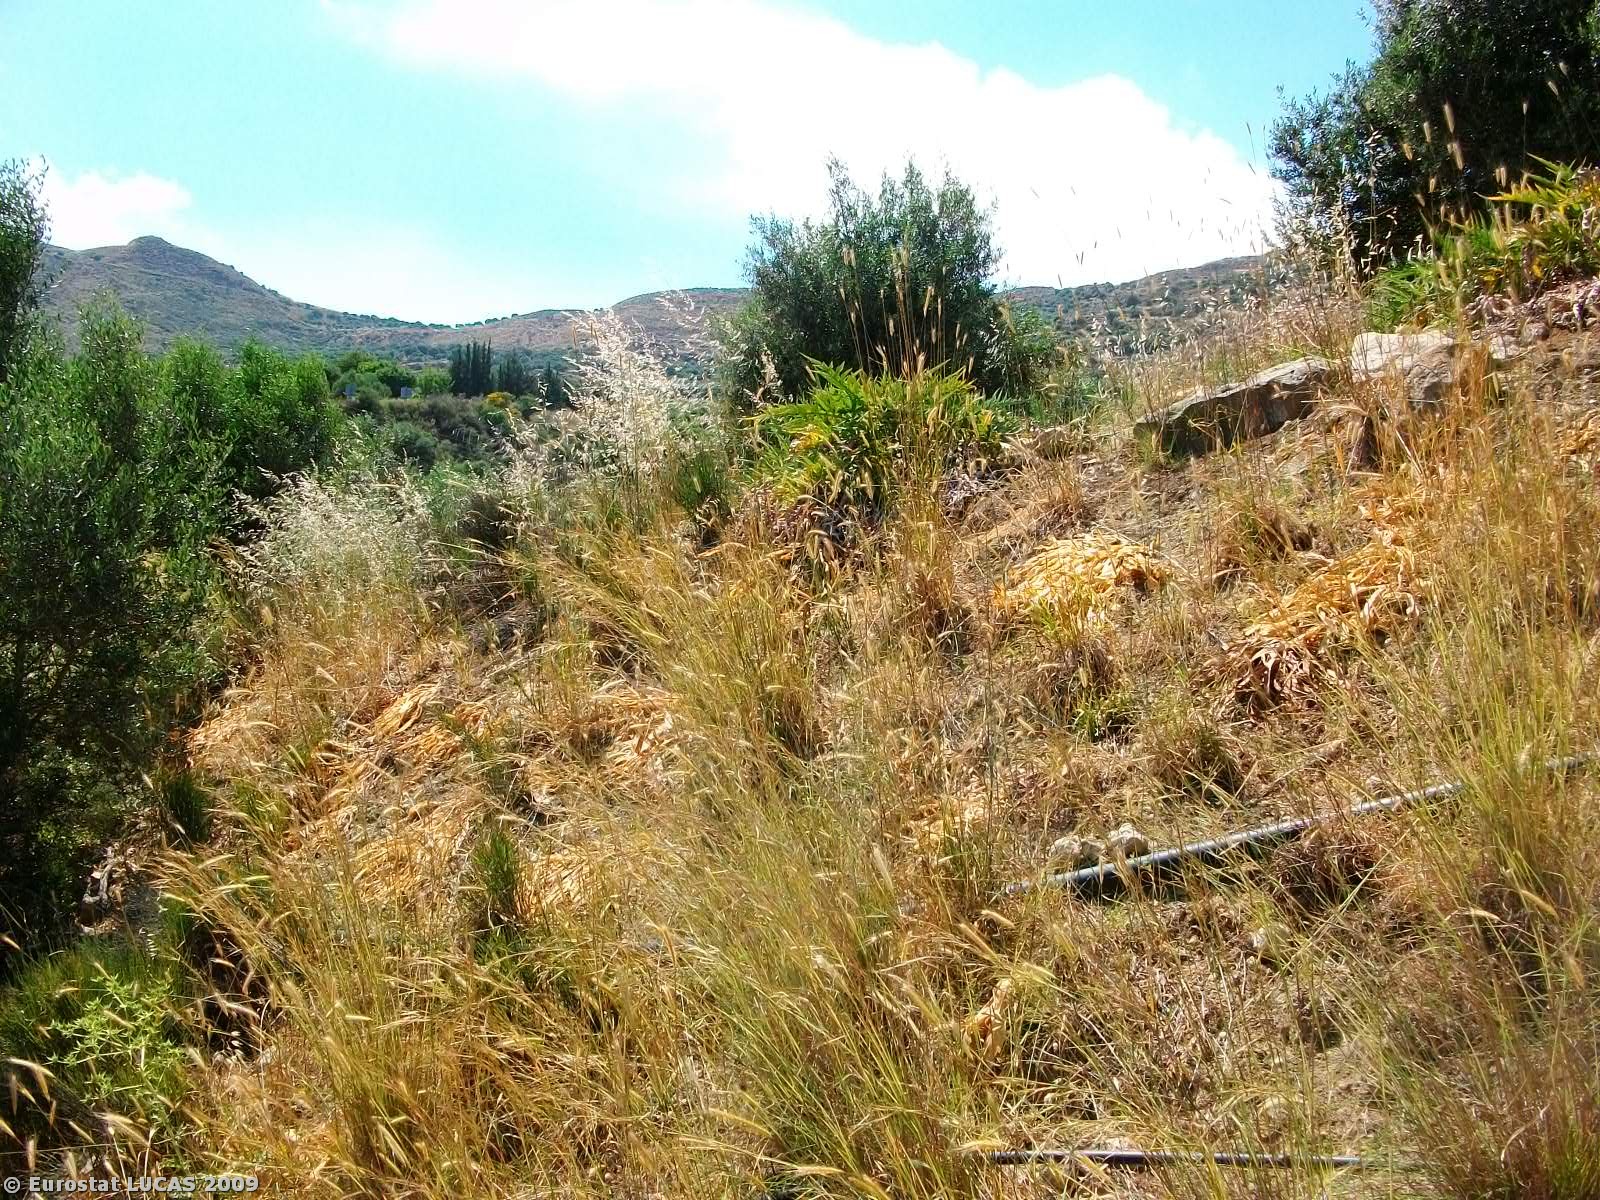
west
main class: Cropland
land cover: Olive groves
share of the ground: 50 - 75 %
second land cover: Bare land
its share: > 75 %
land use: Agriculture (excluding fallow land and kitchen gardens)
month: June
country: GR
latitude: 35.0833
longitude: 24.9574
